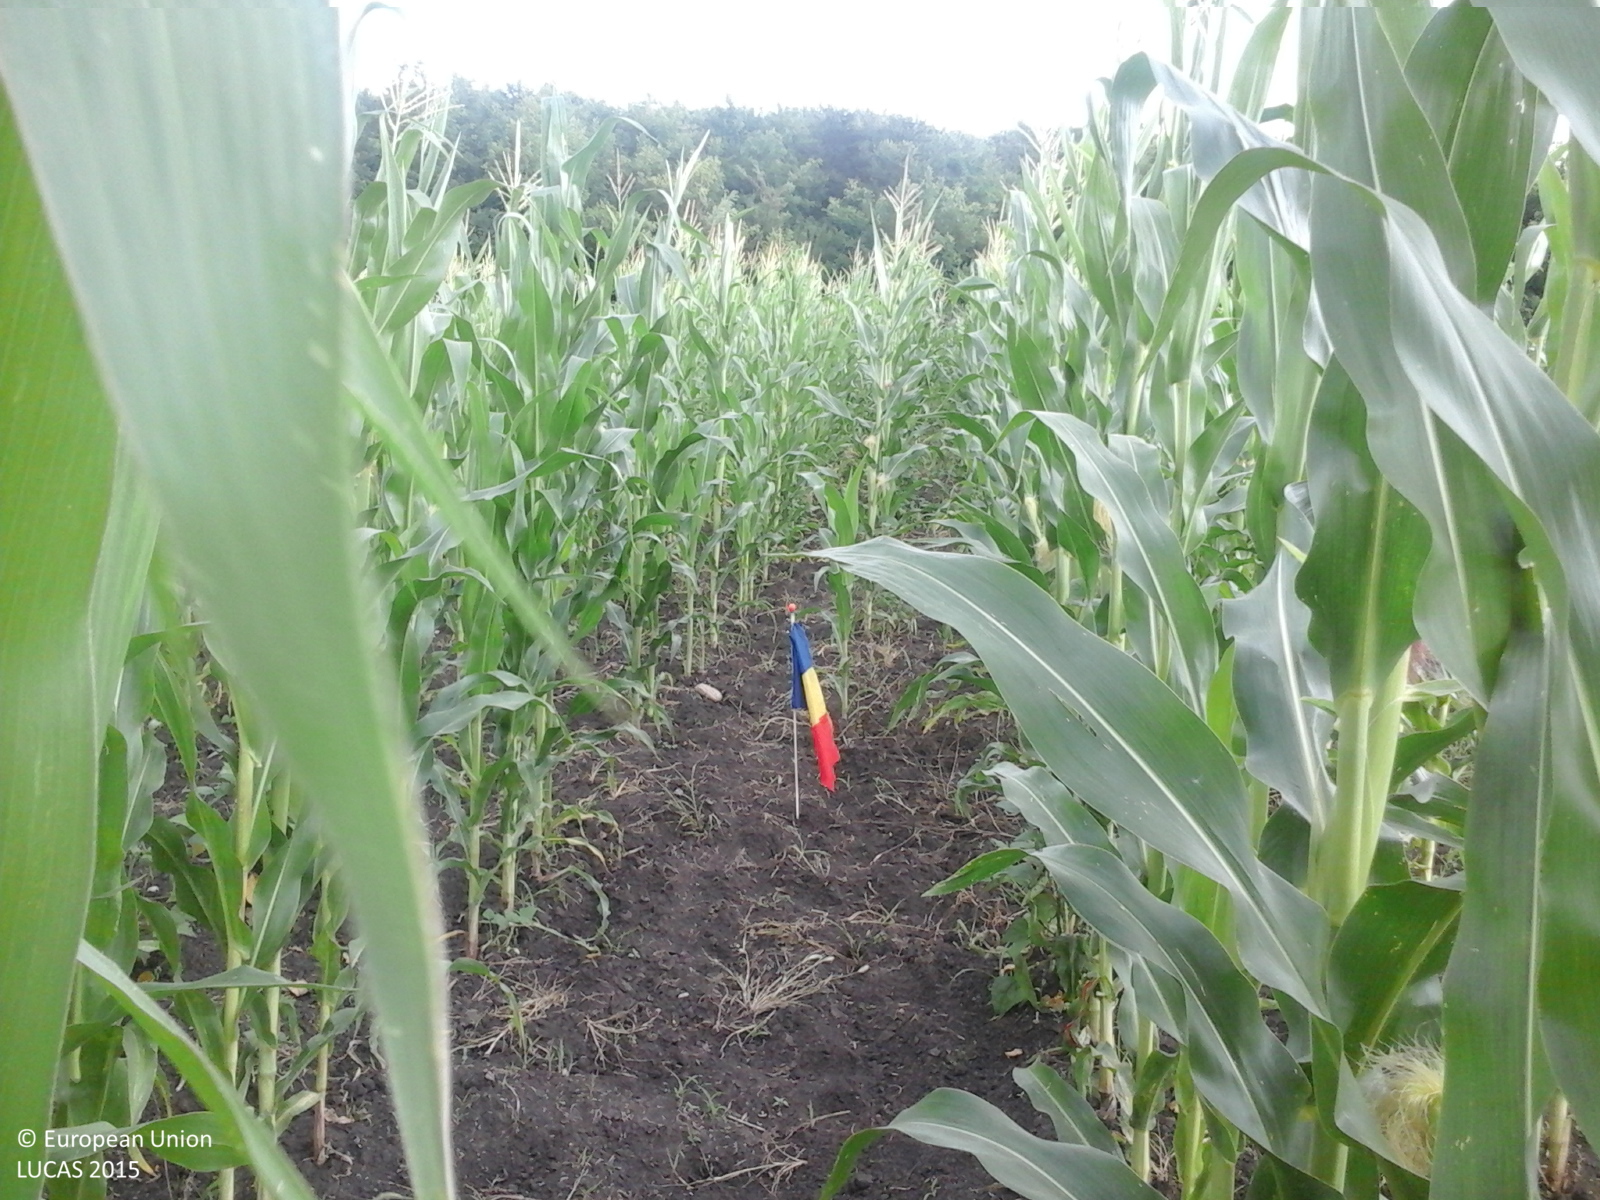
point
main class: Cropland
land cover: Maize
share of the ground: > 75 %
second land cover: Dry pulses
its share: < 10 %
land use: Agriculture (excluding fallow land and kitchen gardens)
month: July
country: RO
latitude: 43.8546
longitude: 25.1432
